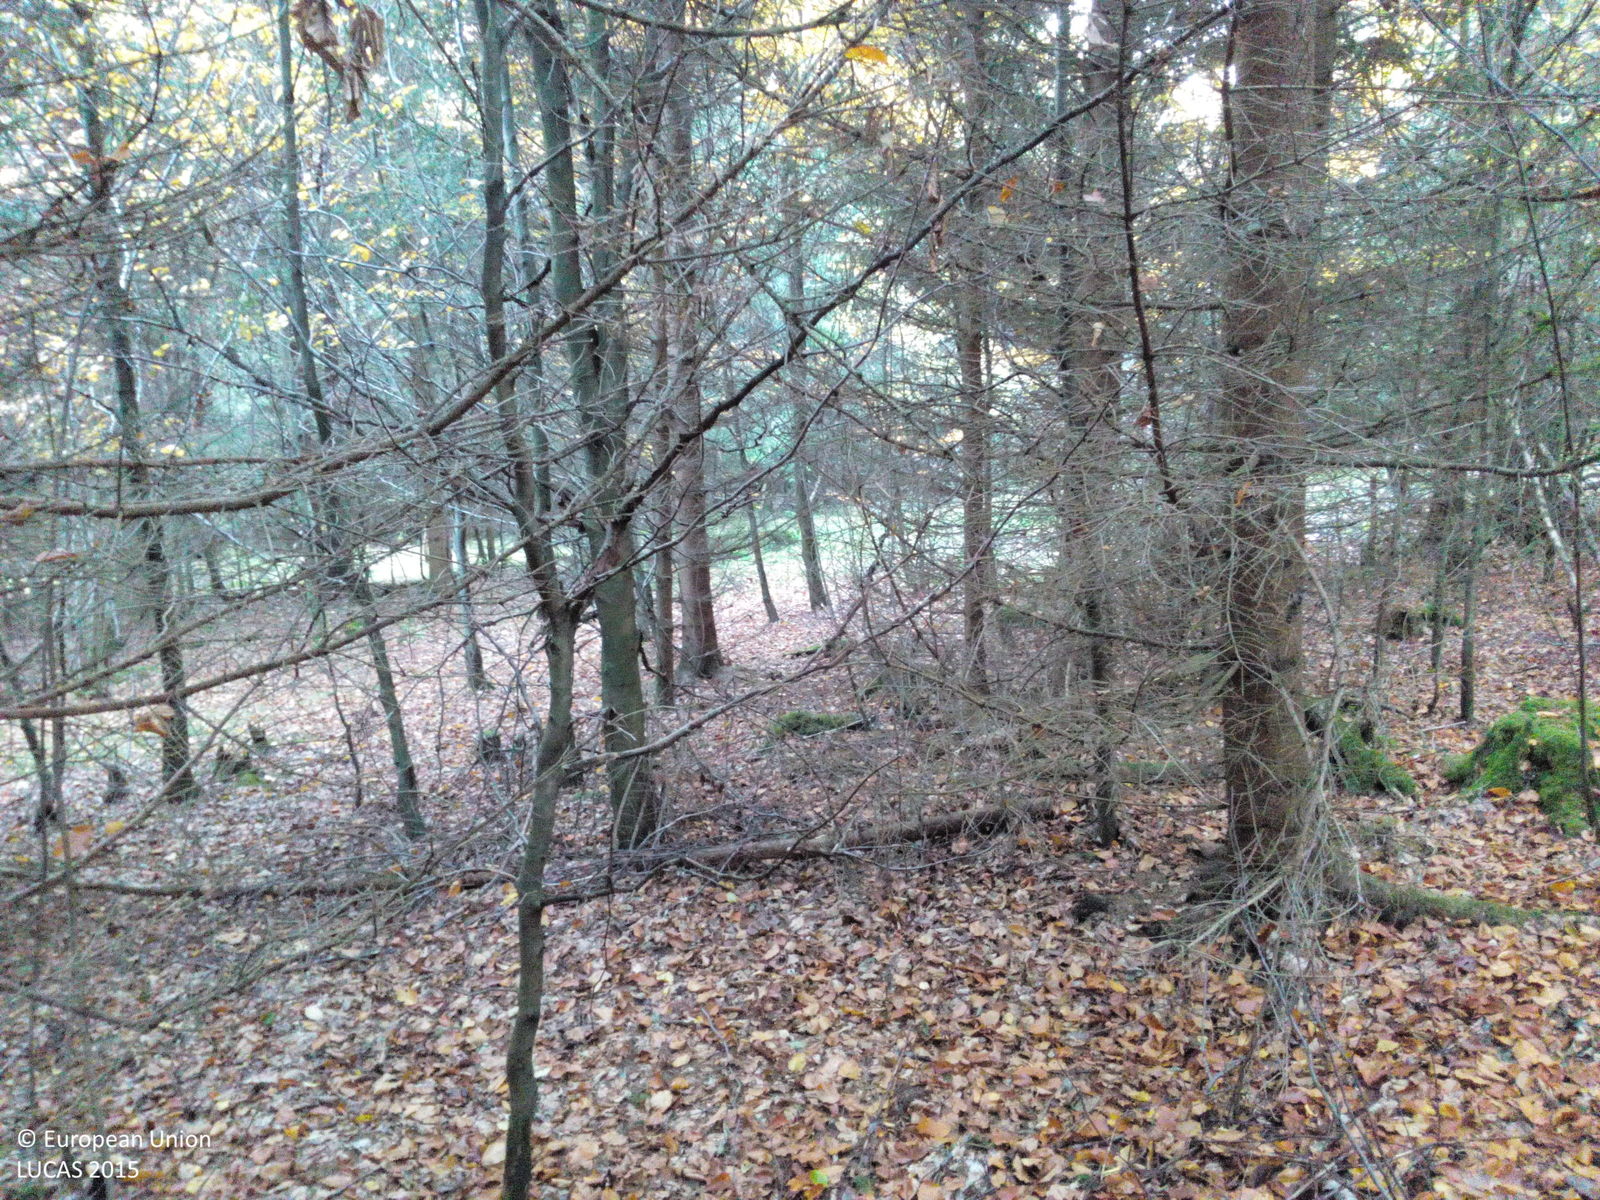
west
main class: Woodland
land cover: Spruce dominated mixed woodland
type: hemiboreal forest and nemoral coniferous forest and mixed broadleaved-coniferous forest
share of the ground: > 75 %
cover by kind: coniferous forest trees 45 %, broadleaved forest trees 30 %, lichens and mosses 15 %, unconsolidated bare surface 10 %
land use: Forestry
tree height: > 5 m
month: October
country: DE
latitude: 50.3280
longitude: 9.9017
